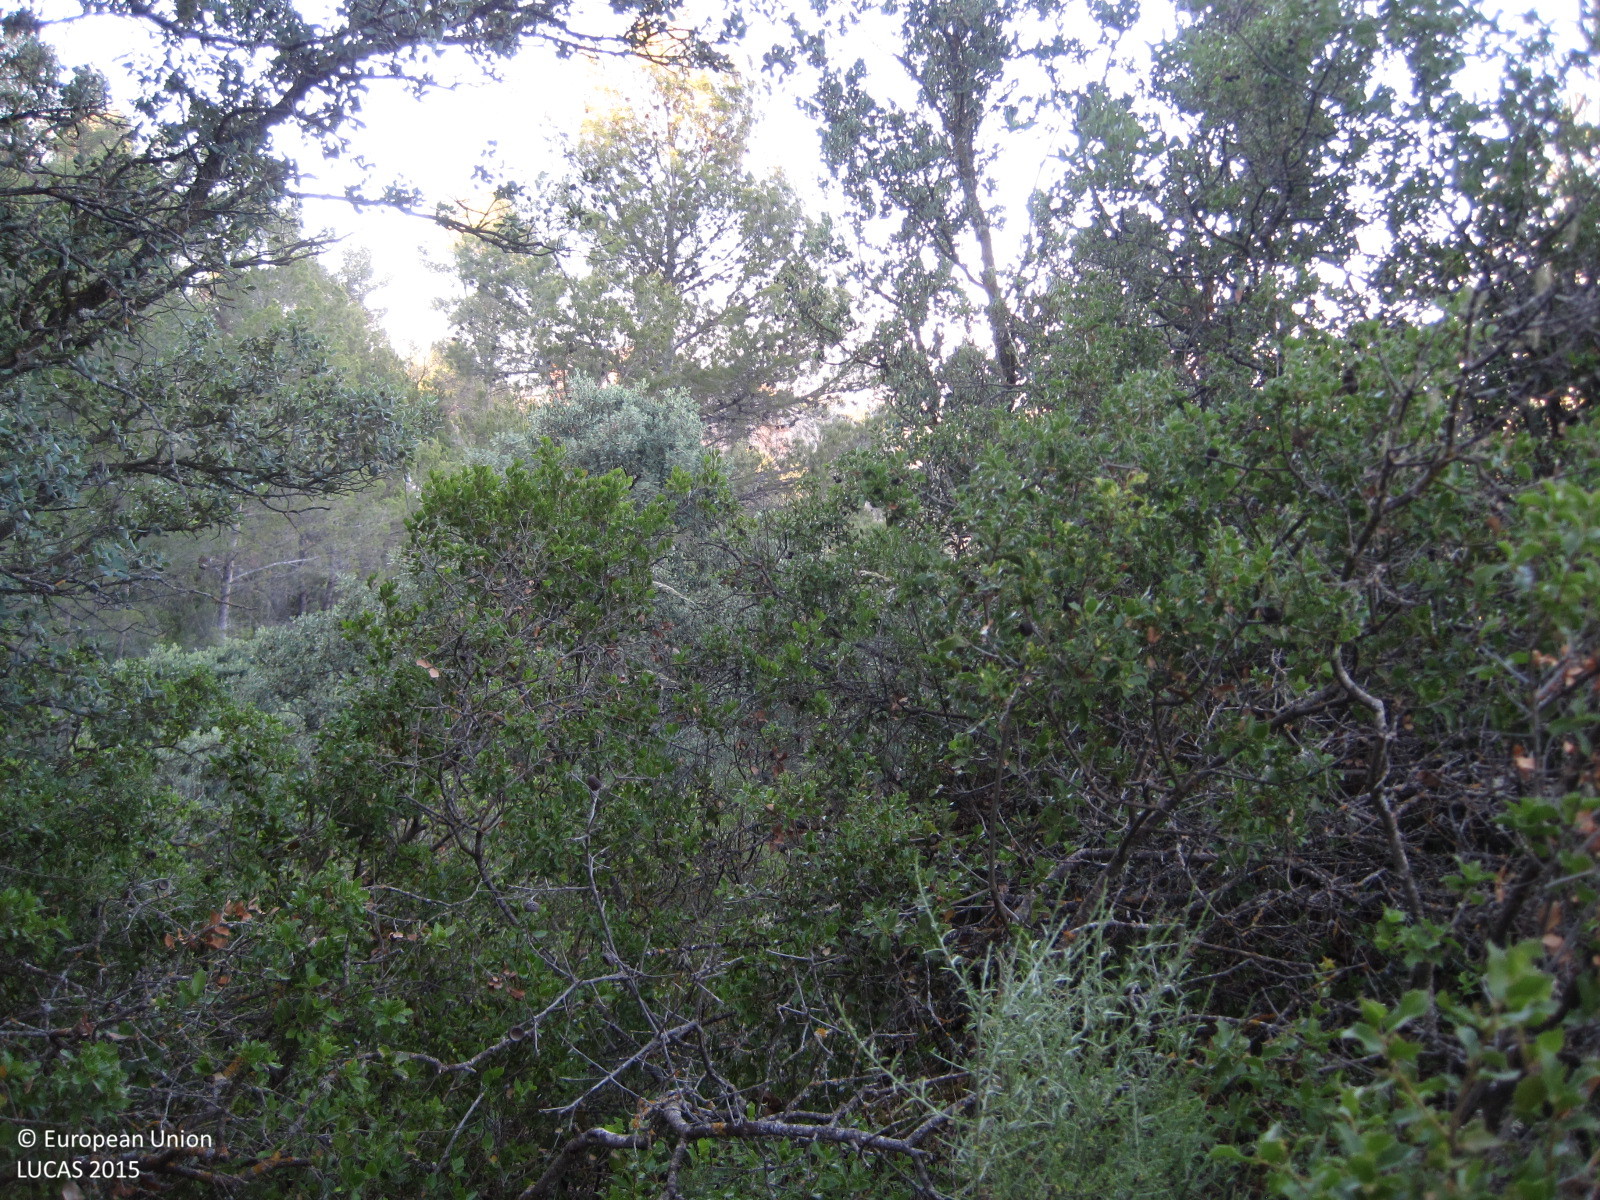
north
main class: Woodland
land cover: Broadleaved woodland
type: broadleaved evergreen forest
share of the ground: 50 - 75 %
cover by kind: broadleaved forest trees 50 %, shrubs 25 %, coniferous forest trees 15 %, herbaceous plants 10 %
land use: Forestry
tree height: > 5 m
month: May
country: ES
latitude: 39.4378
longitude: -1.0731
